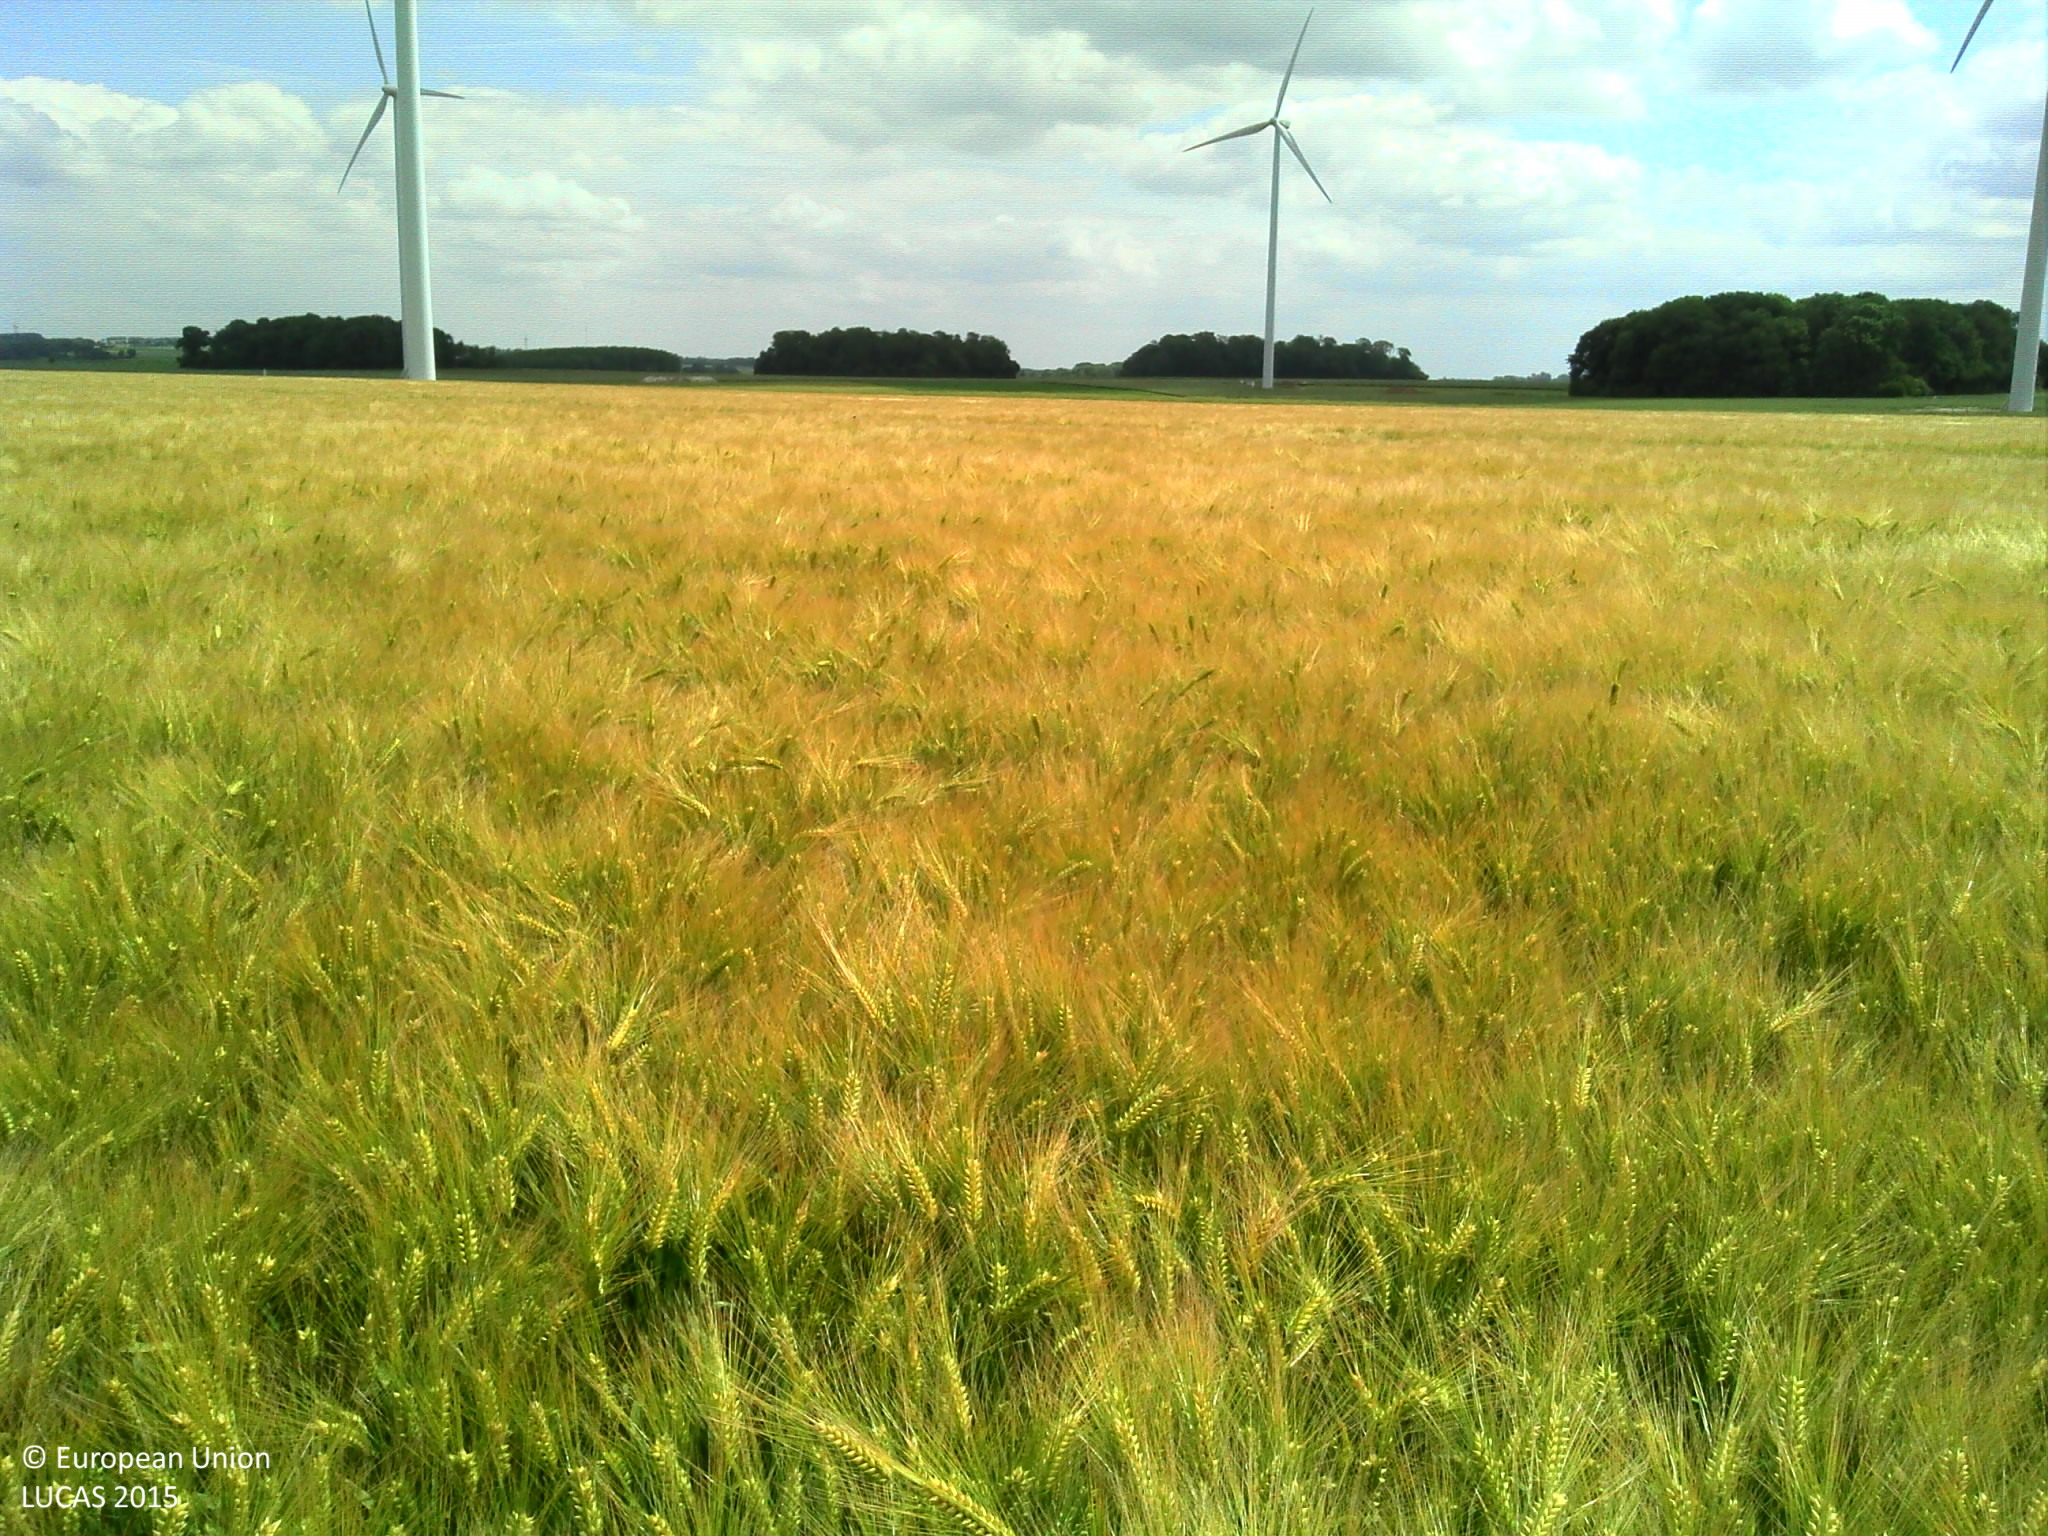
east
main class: Cropland
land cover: Barley
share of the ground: > 75 %
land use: Agriculture (excluding fallow land and kitchen gardens)
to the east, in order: Barley; Rape and turnip rape
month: June
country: FR
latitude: 50.3861
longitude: 2.4627
